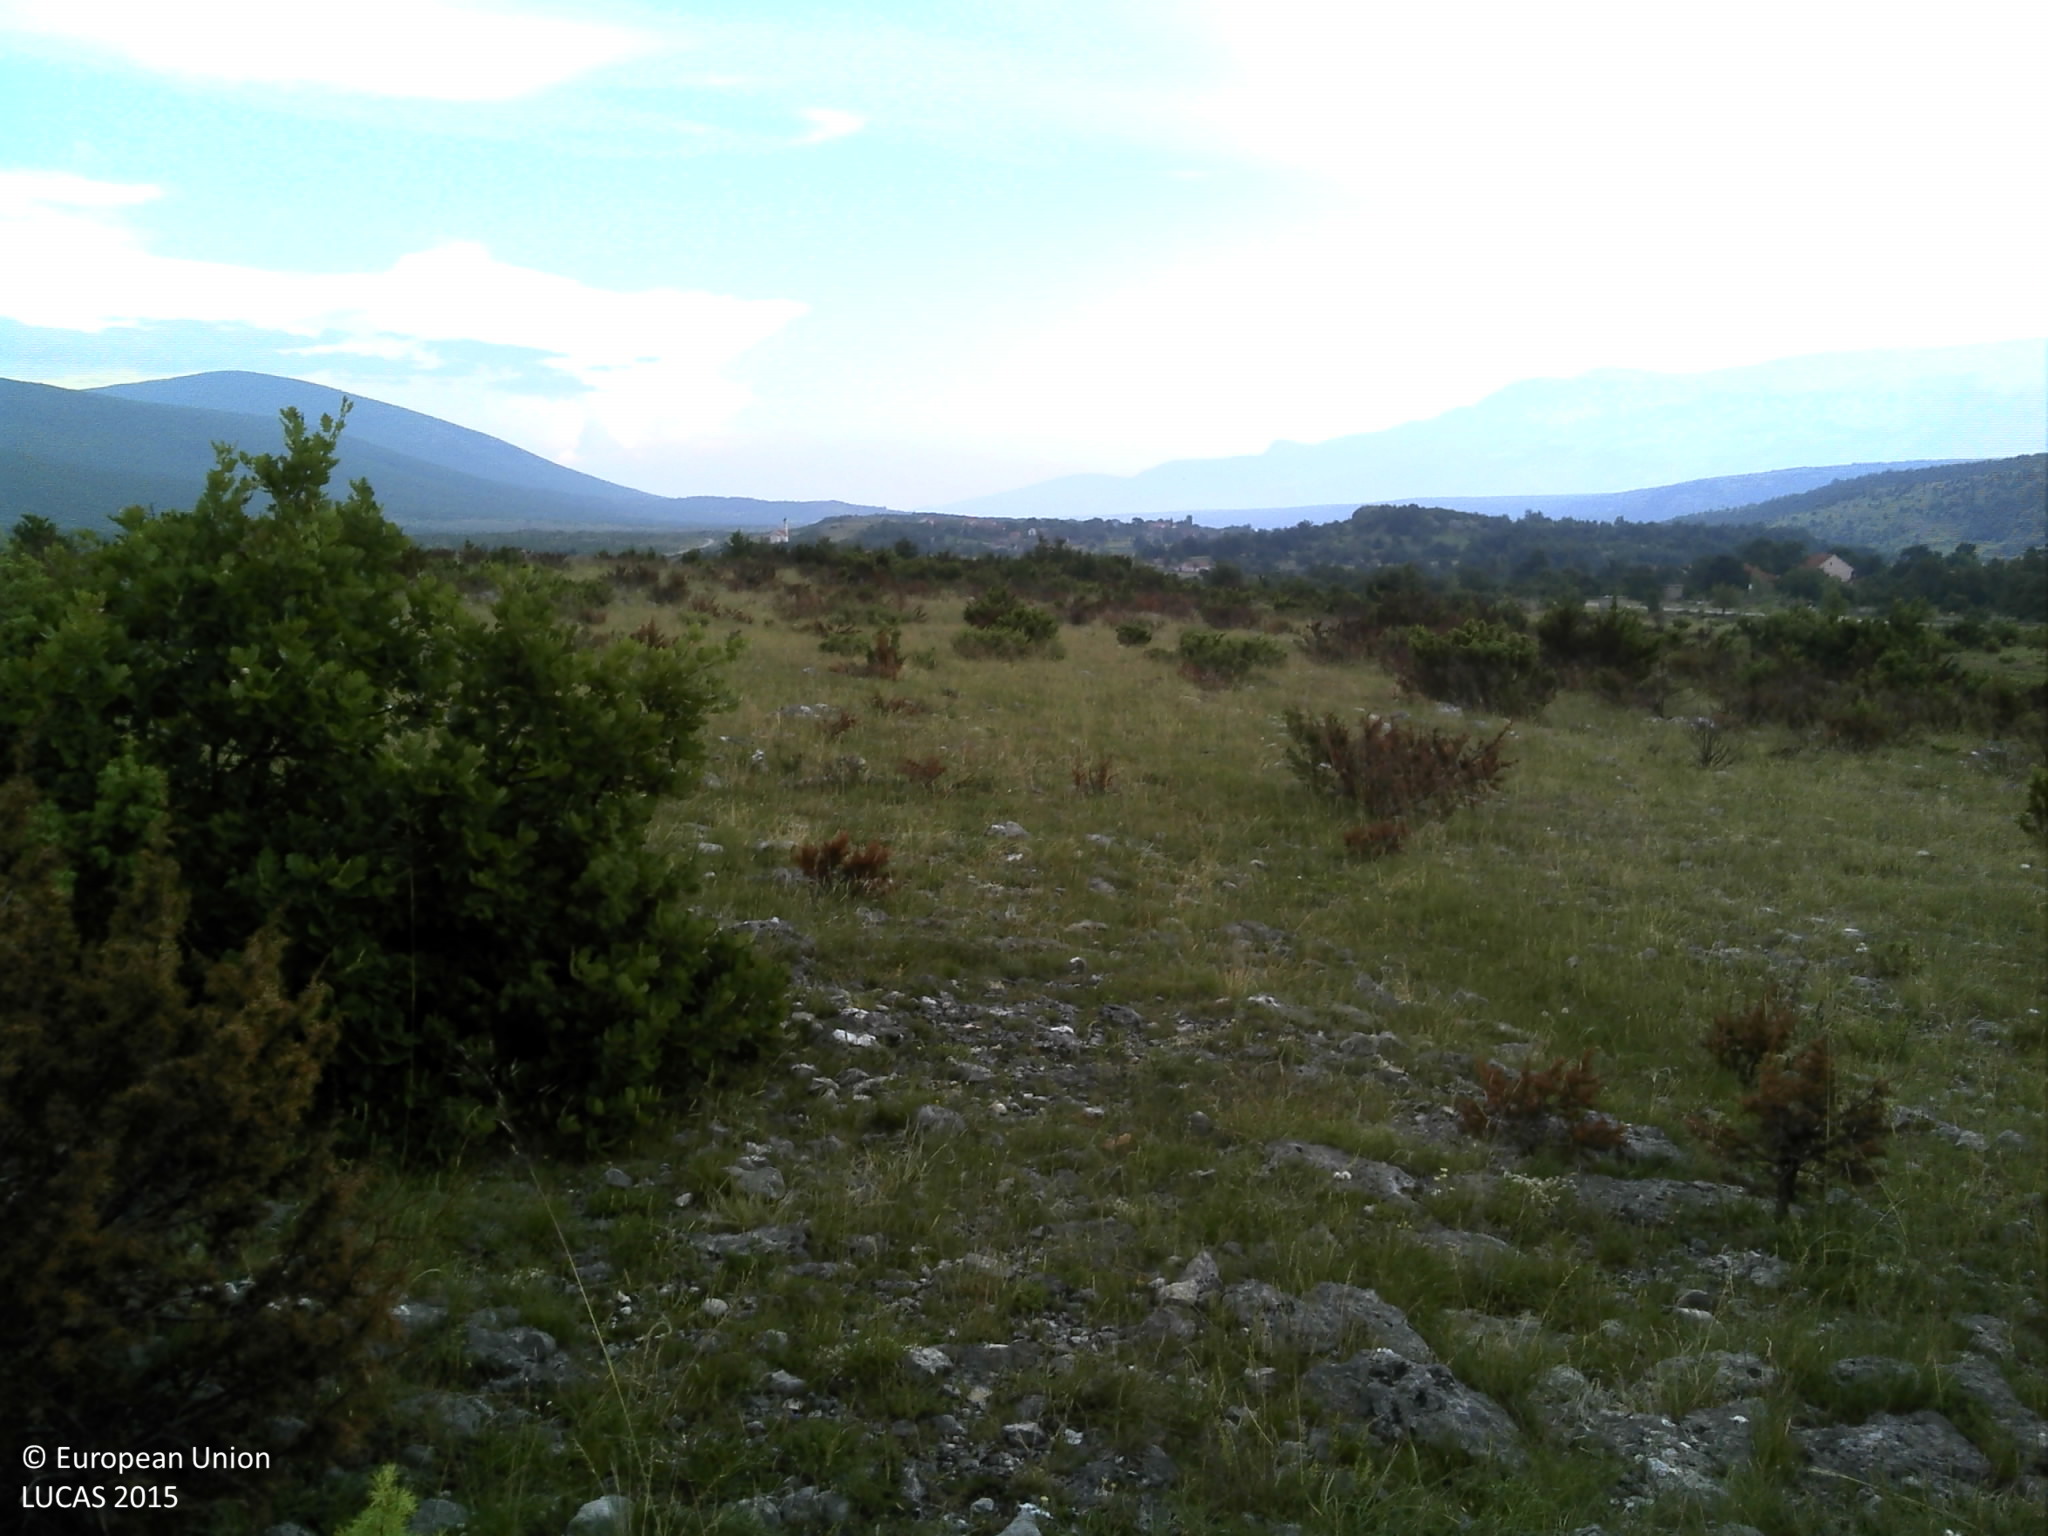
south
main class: Shrubland
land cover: Shrubland with sparse tree cover
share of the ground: 10 - 25 %
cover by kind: herbaceous plants 45 %, shrubs 20 %, unconsolidated bare surface 20 %, consolidated bare surface 10 %, broadleaved forest trees 5 %
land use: Agriculture (excluding fallow land and kitchen gardens)
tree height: < 5 m
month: June
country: HR
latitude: 43.9323
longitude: 16.4575
